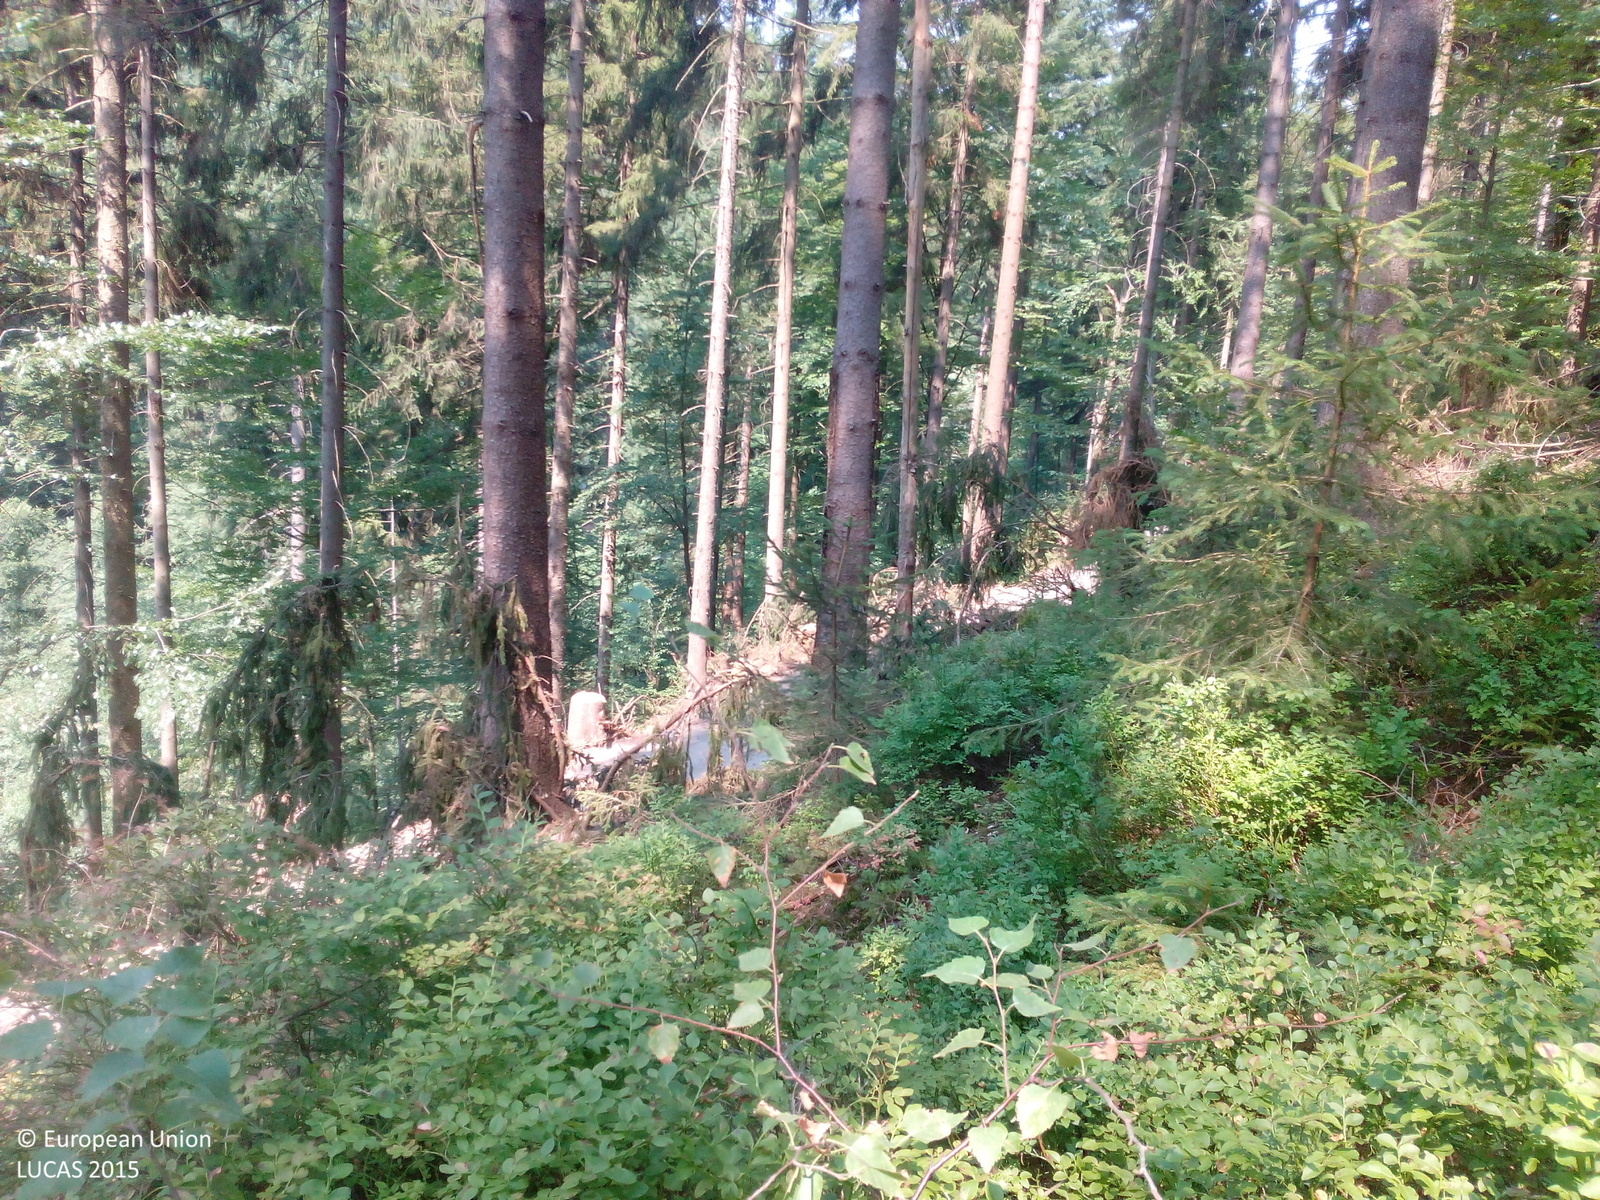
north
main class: Woodland
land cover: Spruce dominated coniferous woodland
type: hemiboreal forest and nemoral coniferous forest and mixed broadleaved-coniferous forest
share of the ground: > 75 %
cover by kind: coniferous forest trees 90 %, shrubs 10 %
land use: Forestry
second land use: Amenities, museums, leisure
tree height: > 5 m
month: August
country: DE
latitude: 50.2991
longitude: 11.5860
